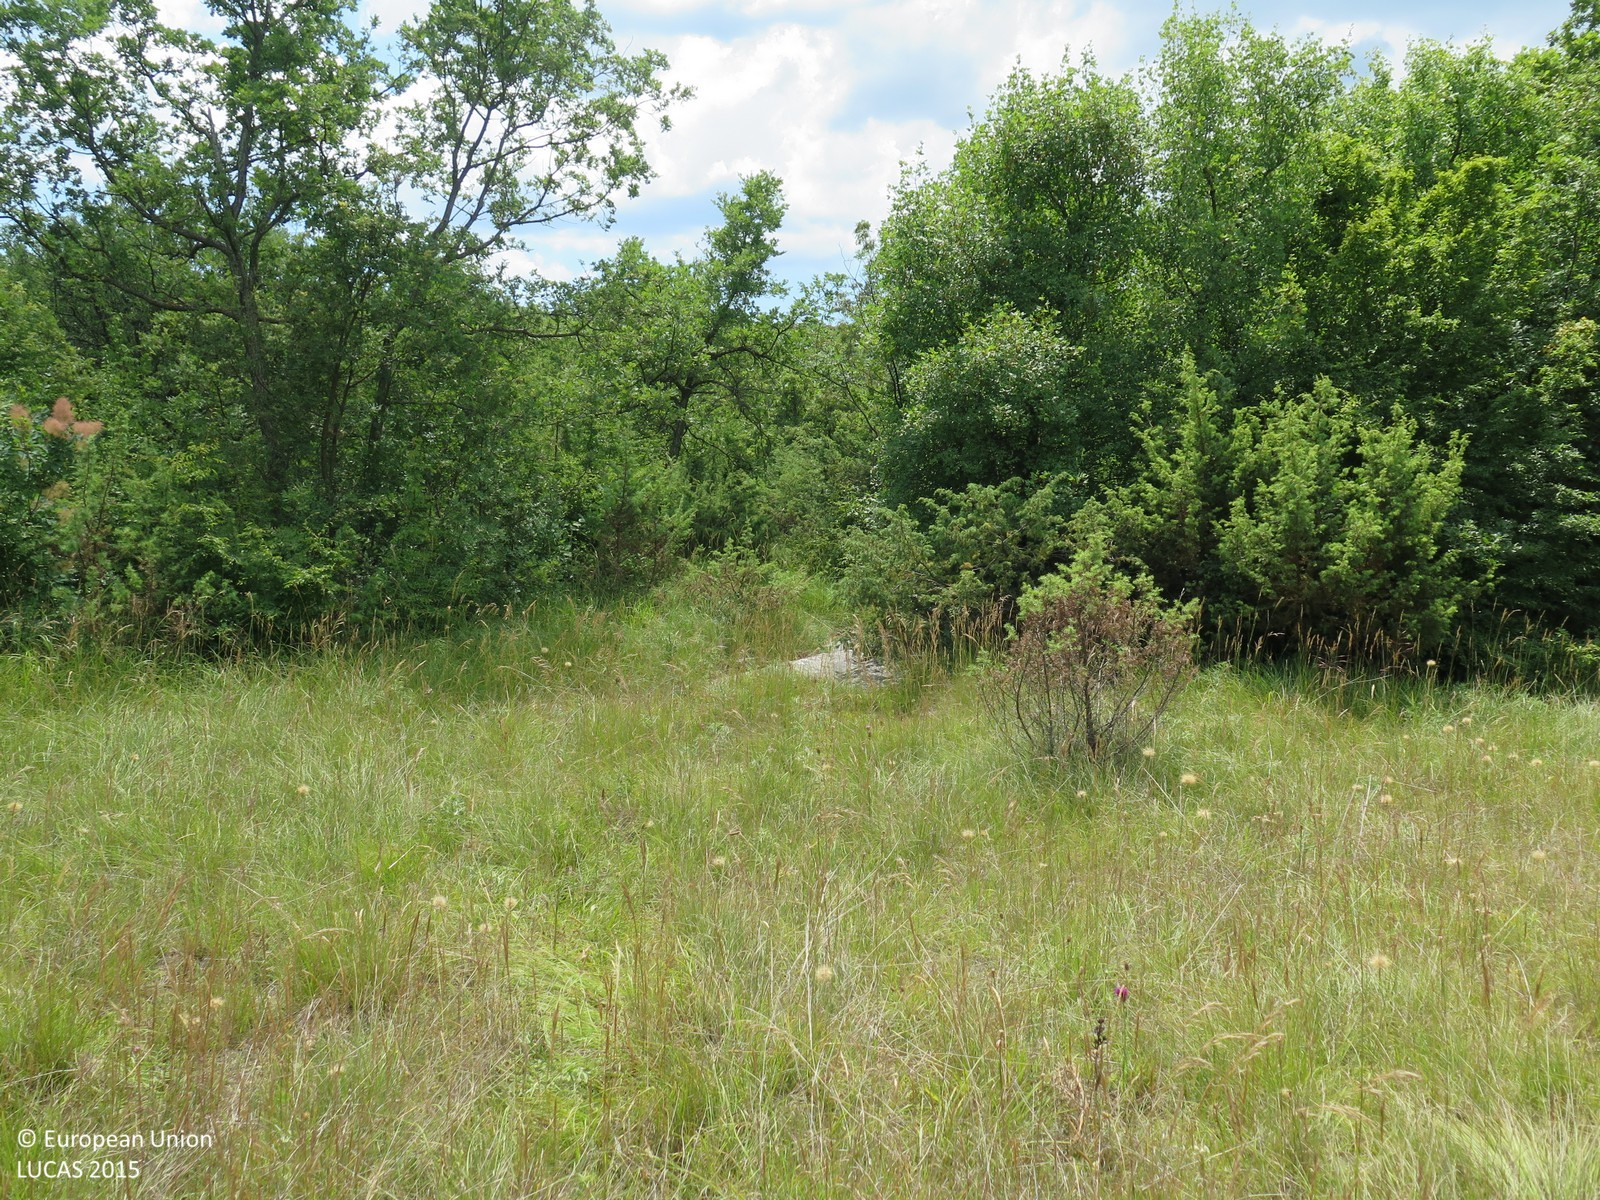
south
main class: Grassland
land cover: Grassland with sparse tree/shrub cover
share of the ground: > 75 %
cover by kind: herbaceous plants 90 %, broadleaved forest trees 5 %, shrubs 5 %
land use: Semi-natural and natural areas not in use
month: June
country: HR
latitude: 45.0640
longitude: 14.0965
